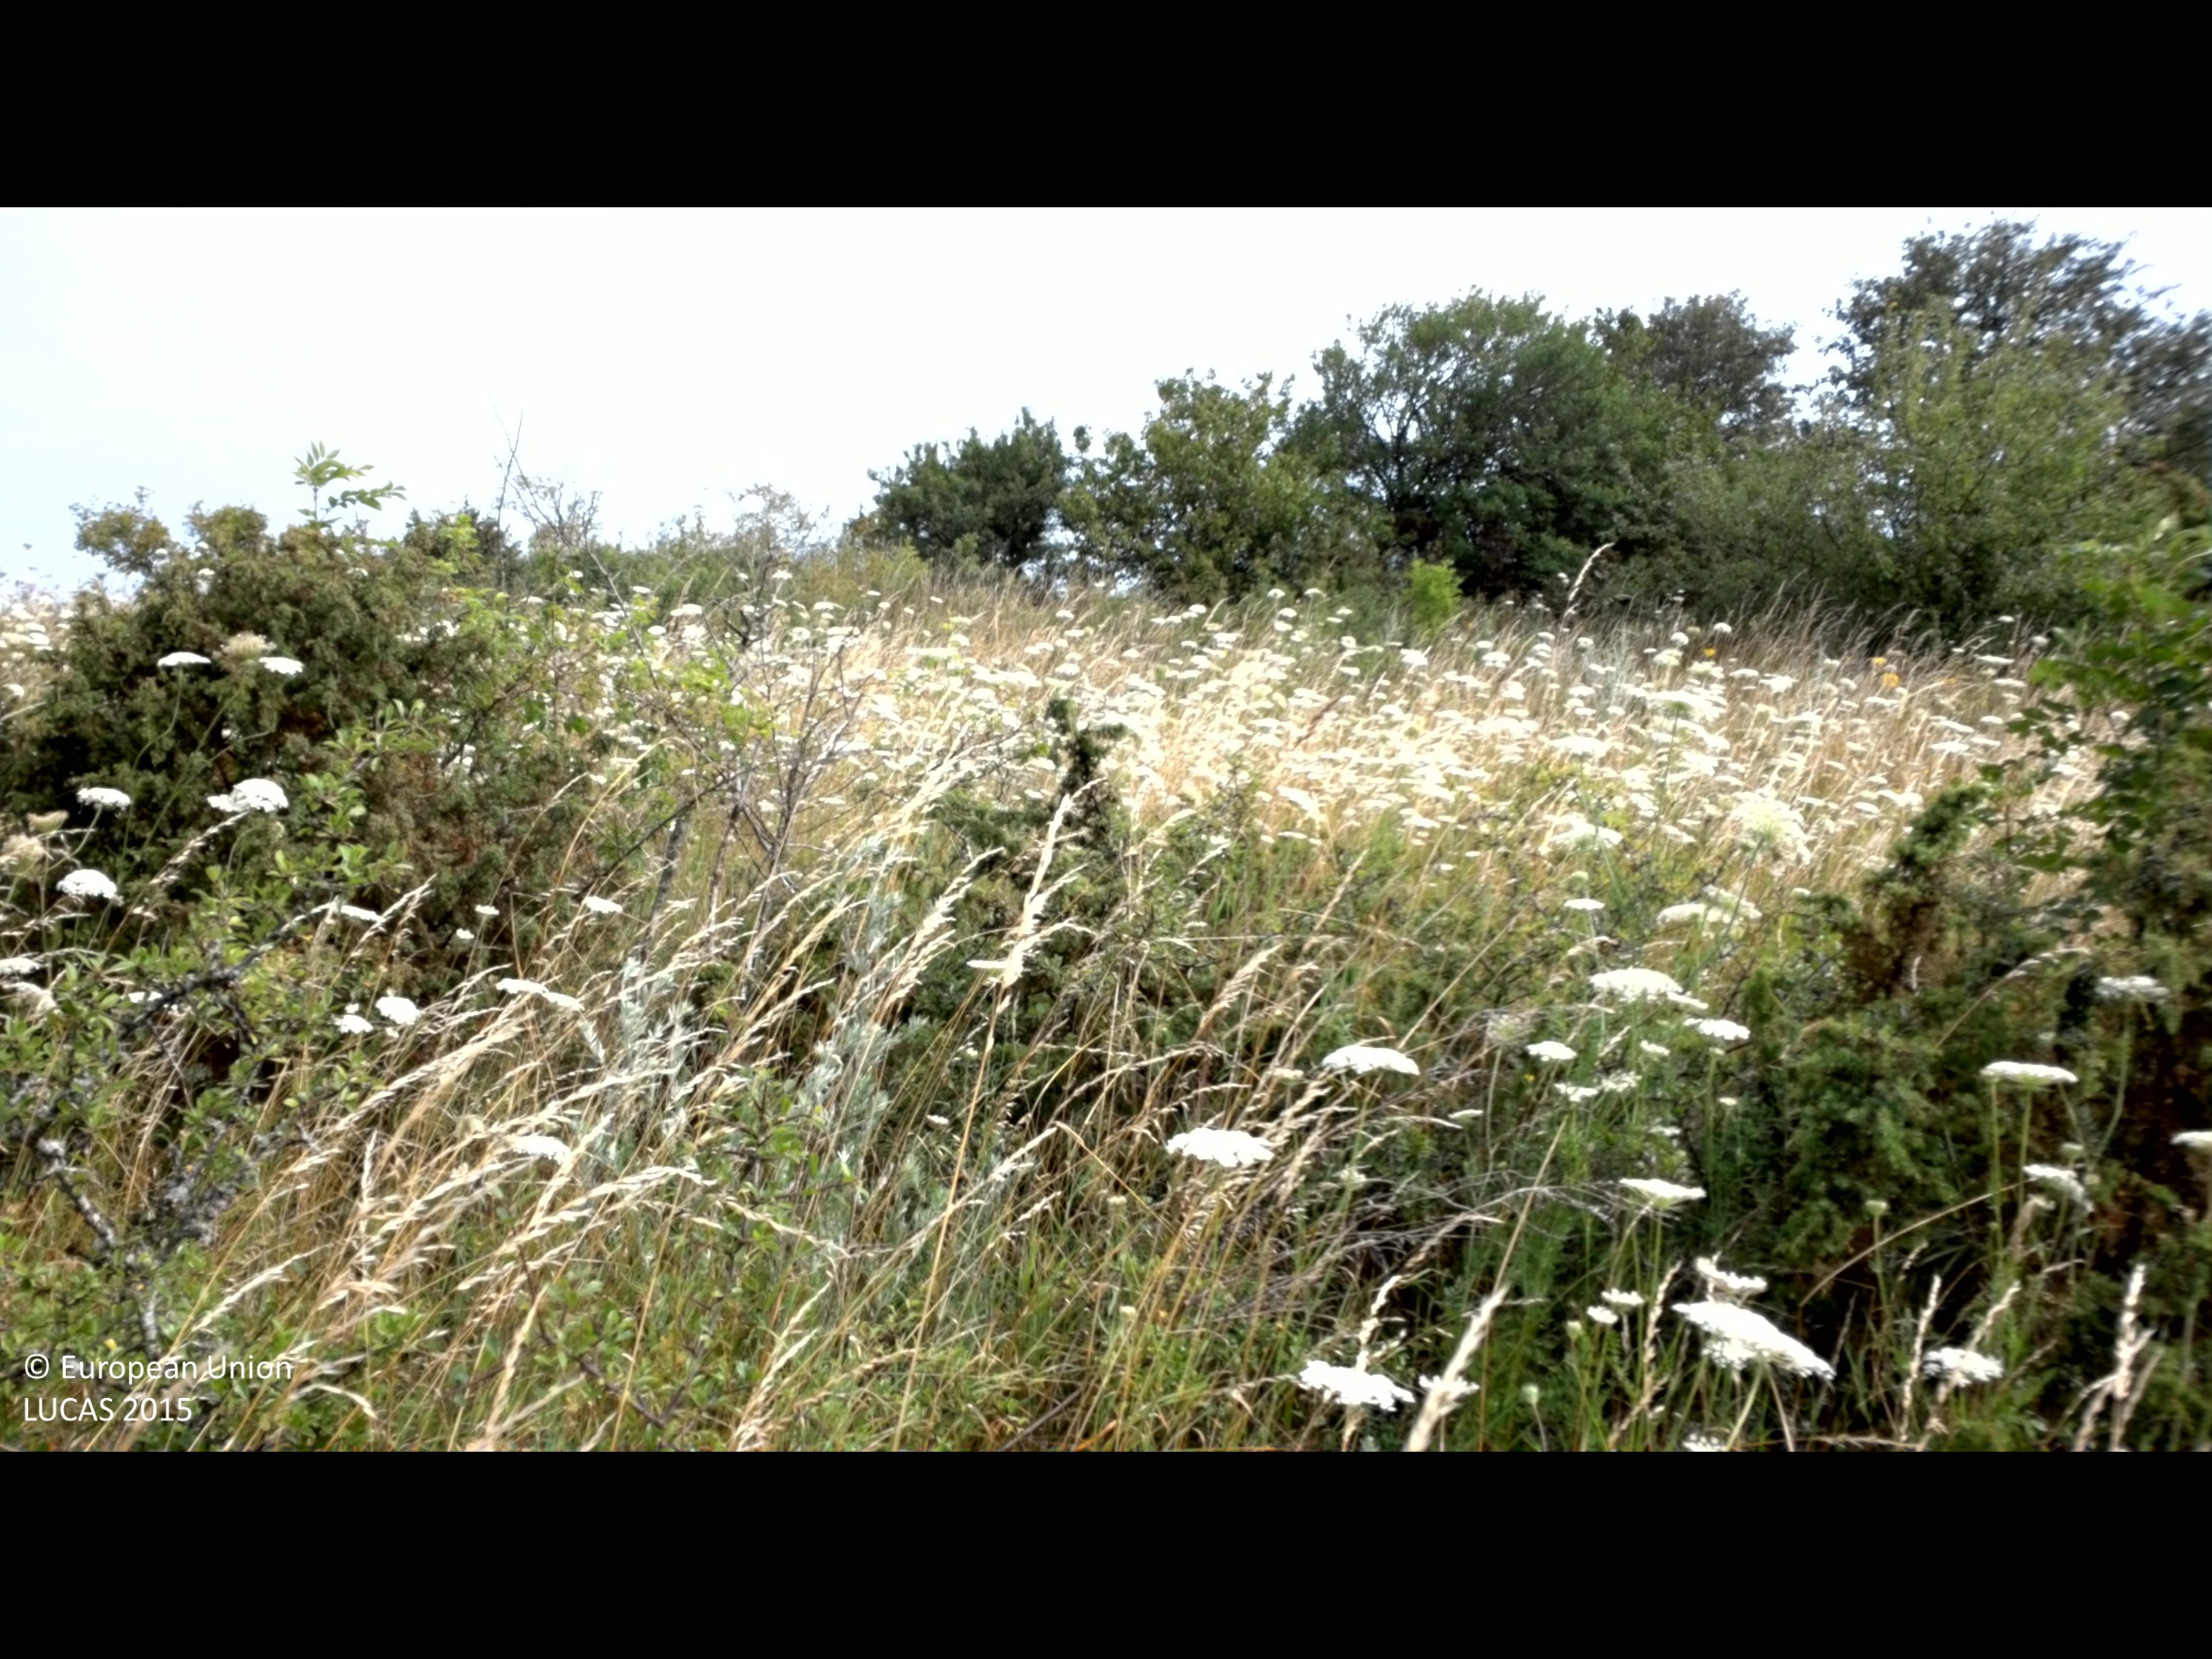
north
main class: Shrubland
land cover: Shrubland with sparse tree cover
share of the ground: > 75 %
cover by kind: shrubs 90 %, broadleaved forest trees 5 %, herbaceous plants 5 %
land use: Semi-natural and natural areas not in use
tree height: < 5 m
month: July
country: SE
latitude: 56.8459
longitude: 16.6414
